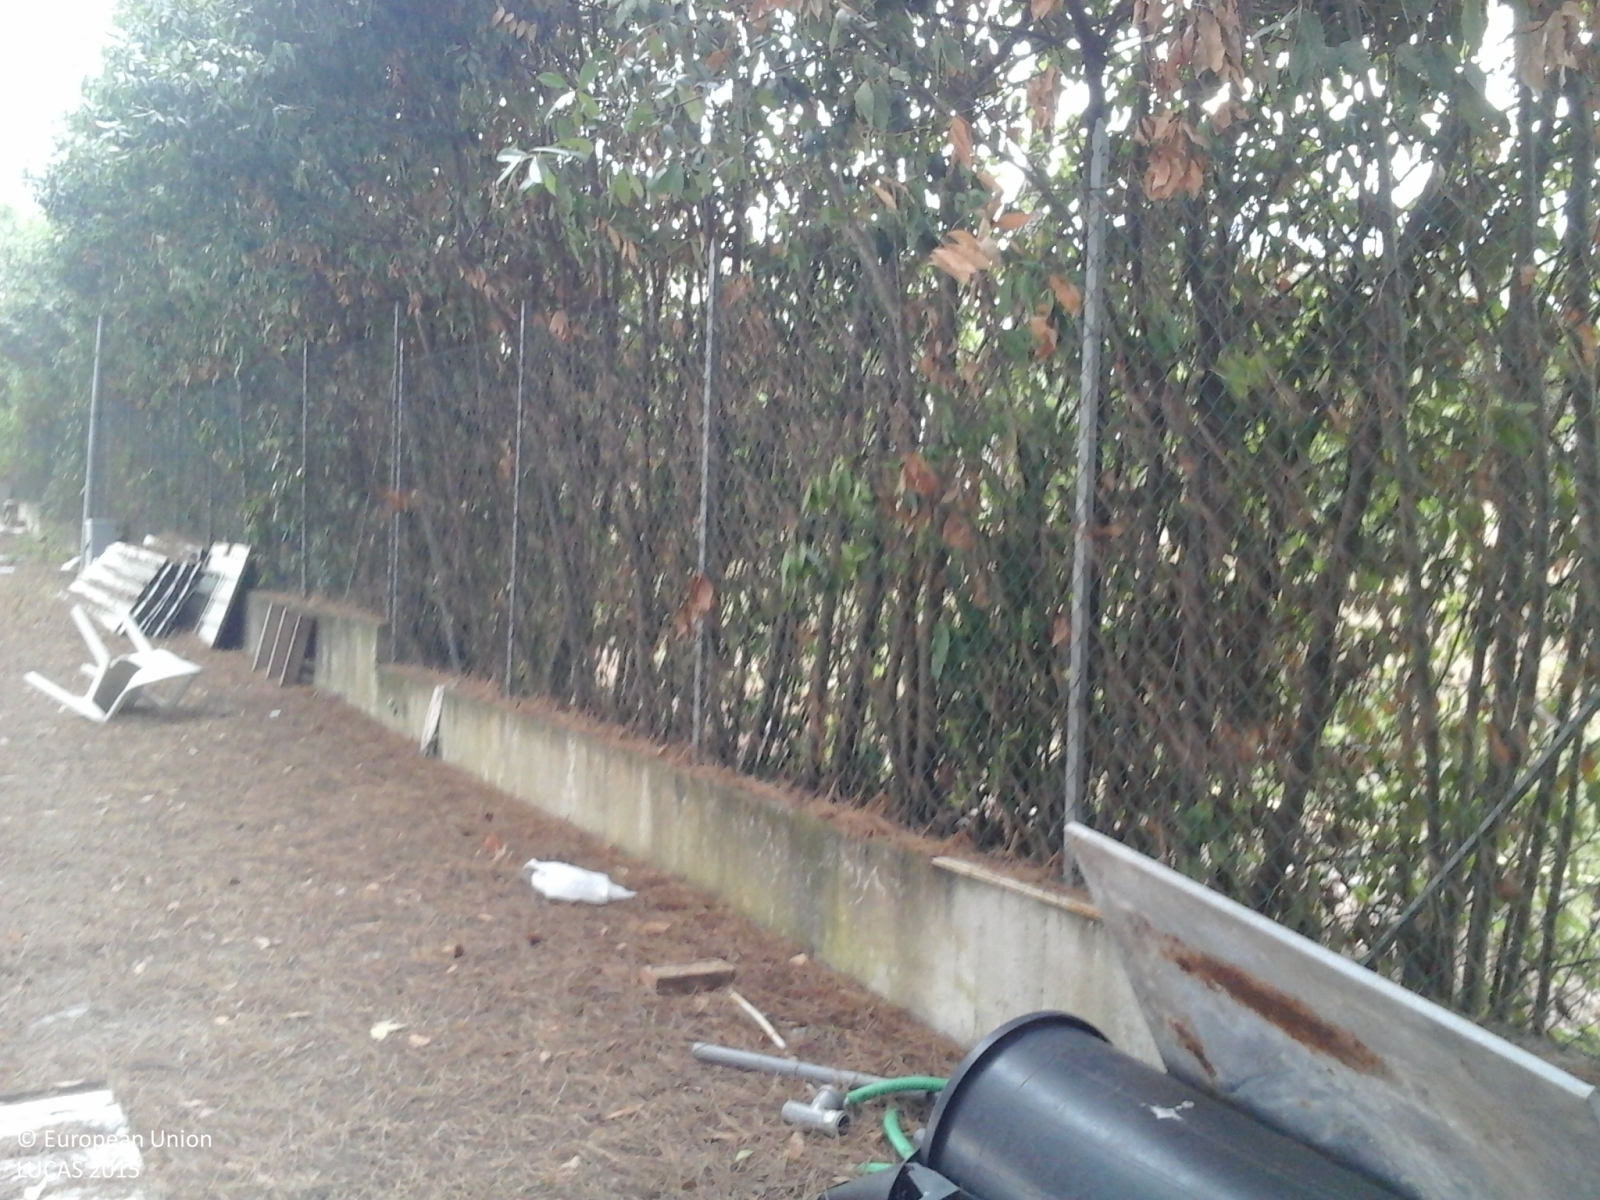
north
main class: Grassland
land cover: Grassland with sparse tree/shrub cover
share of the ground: > 75 %
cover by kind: herbaceous plants 95 %, coniferous forest trees 5 %
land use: Residential
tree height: > 5 m
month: August
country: IT
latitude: 43.8791
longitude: 10.7076
